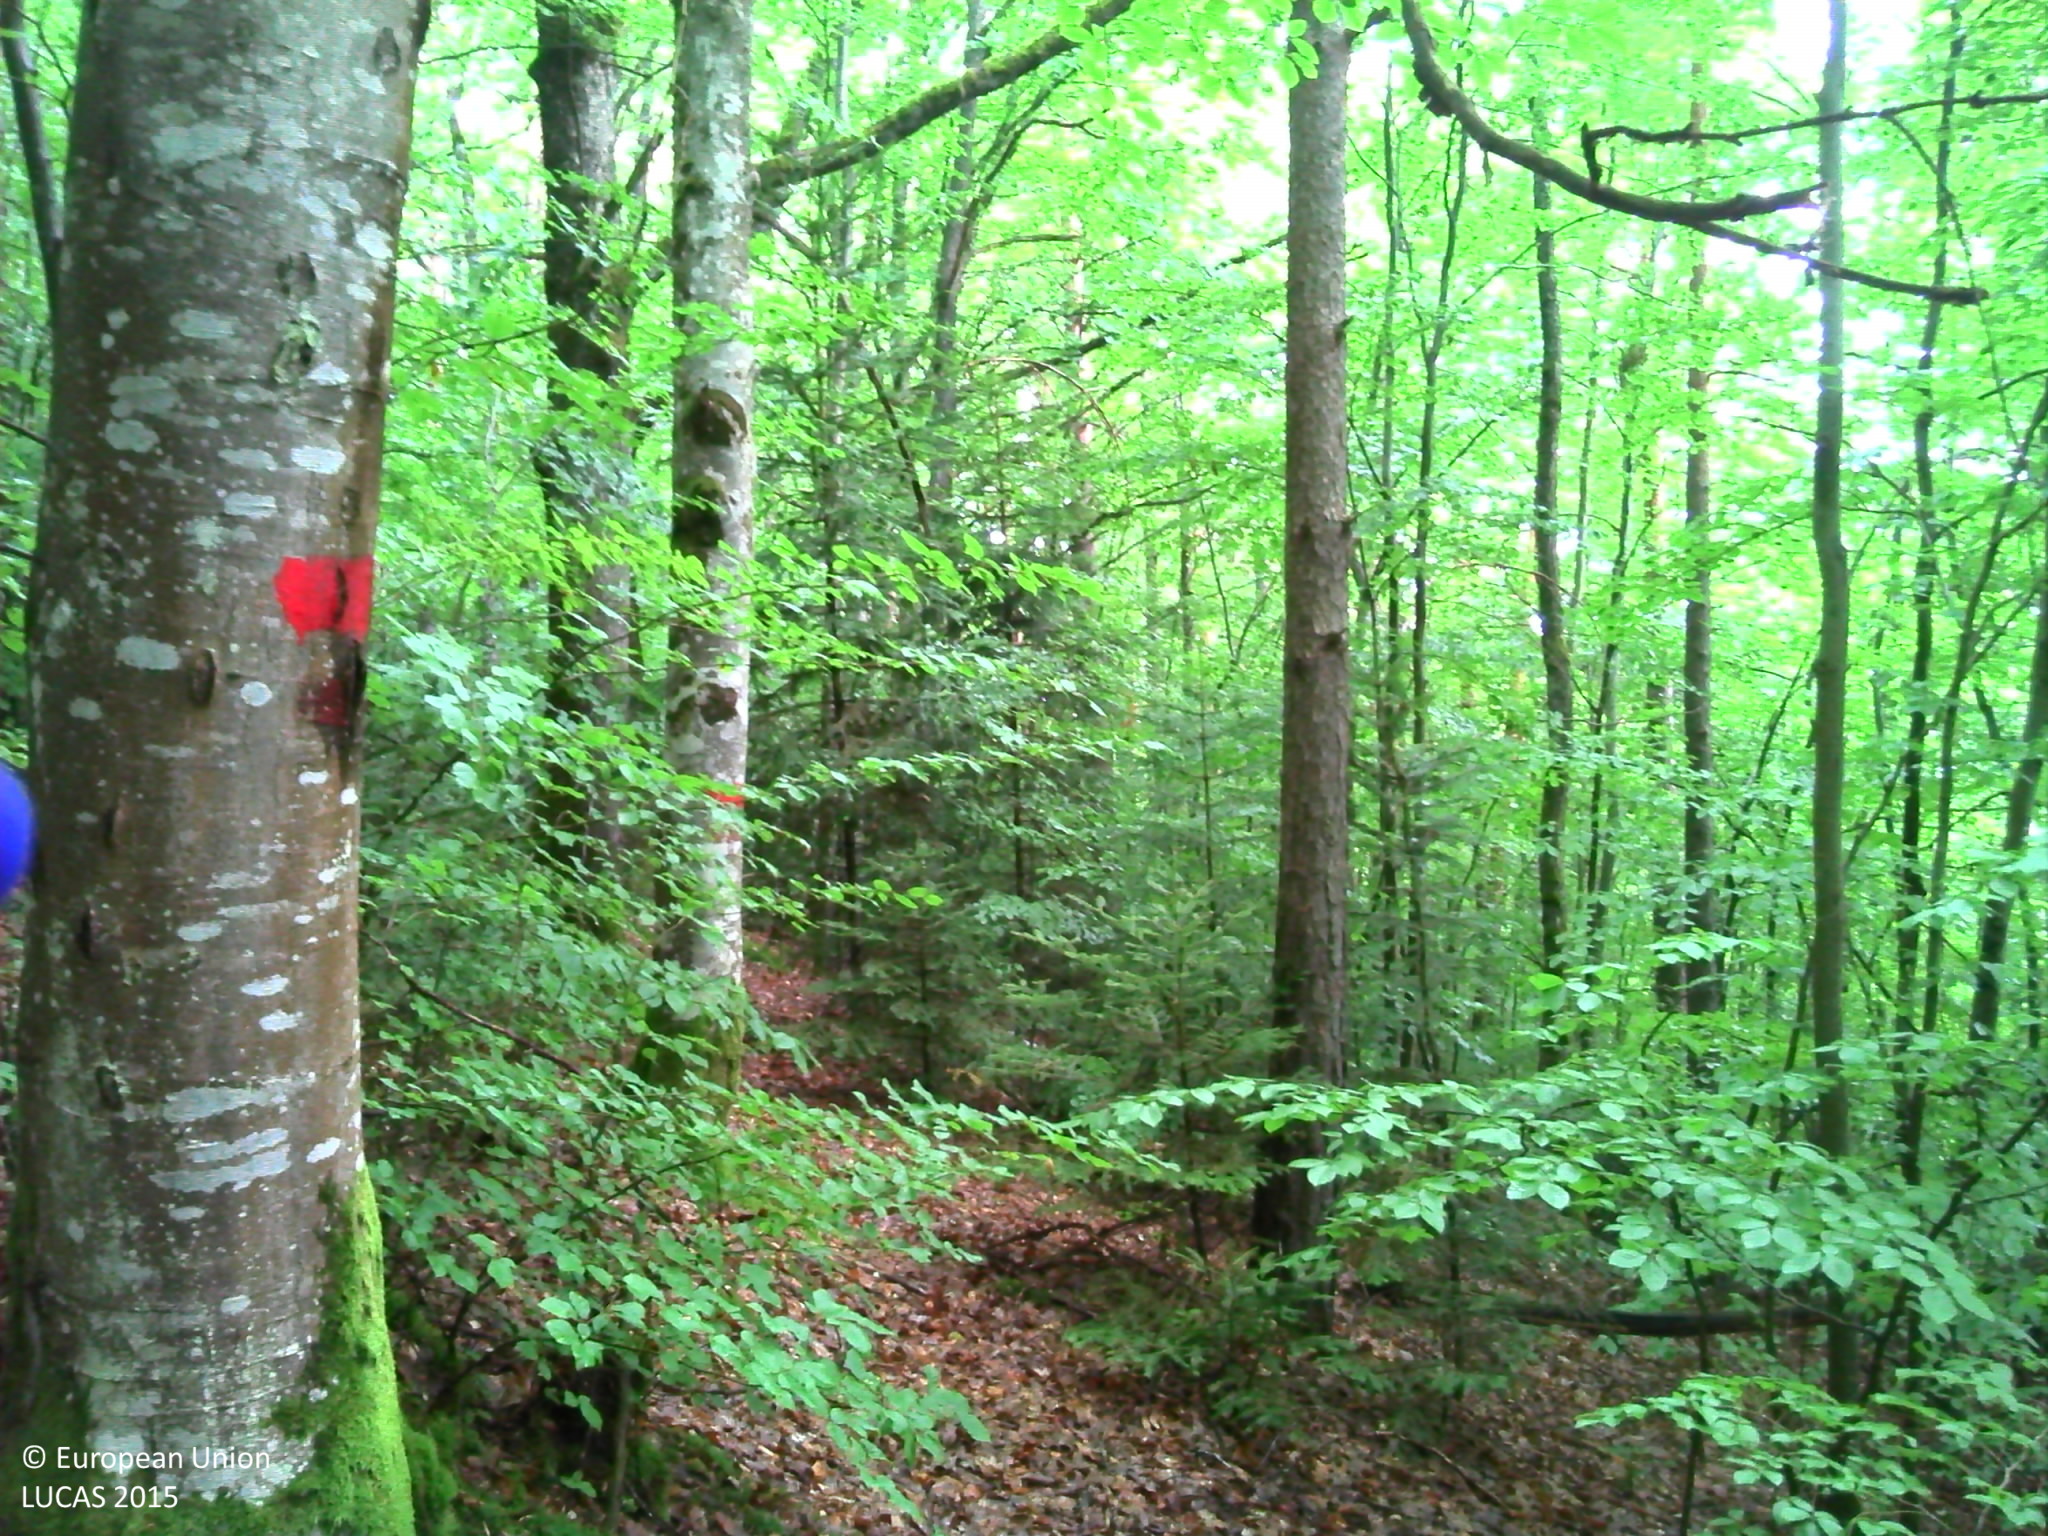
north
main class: Woodland
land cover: Spruce dominated mixed woodland
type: mountainous beech forest
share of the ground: > 75 %
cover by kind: broadleaved forest trees 60 %, coniferous forest trees 20 %, shrubs 10 %, herbaceous plants 5 %, lichens and mosses 5 %
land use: Forestry
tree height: > 5 m
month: July
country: FR
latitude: 45.1983
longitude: 4.1611
